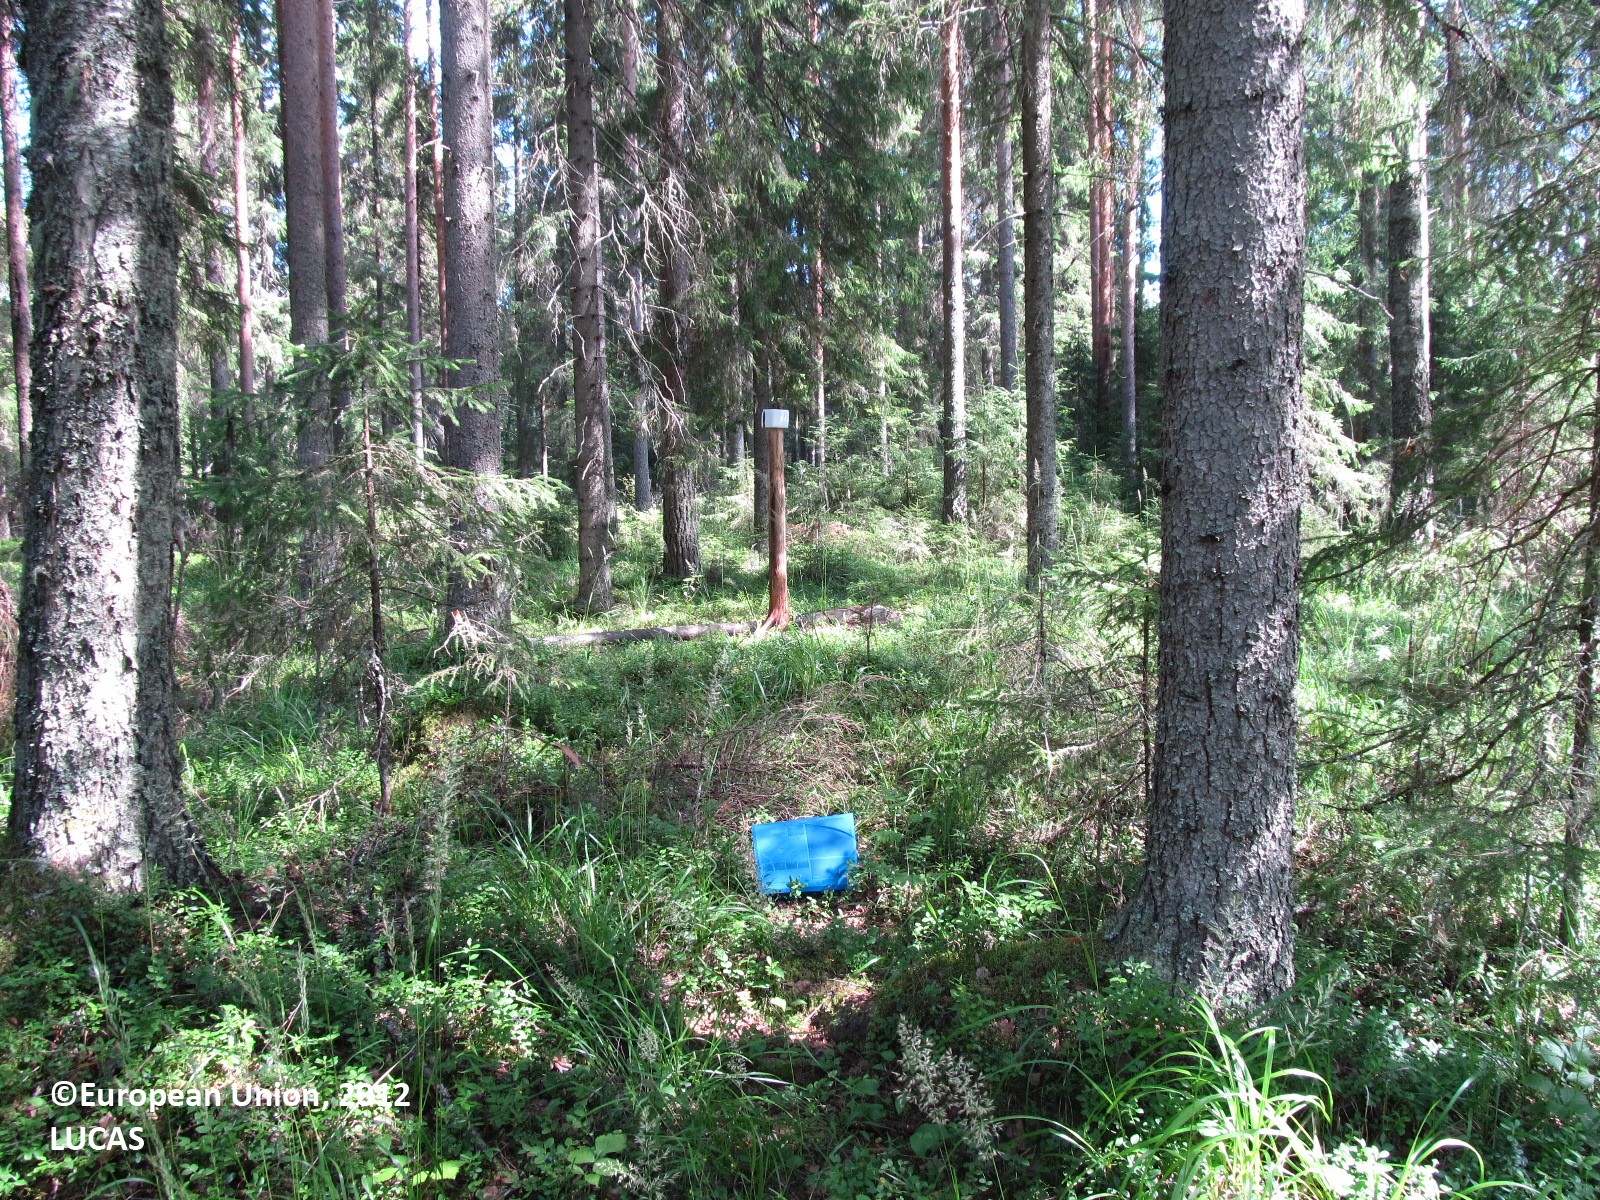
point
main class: Woodland
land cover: Spruce dominated coniferous woodland
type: boreal forest
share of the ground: 50 - 75 %
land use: Forestry
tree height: > 5 m
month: July
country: FI
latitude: 61.9482
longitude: 27.9336
